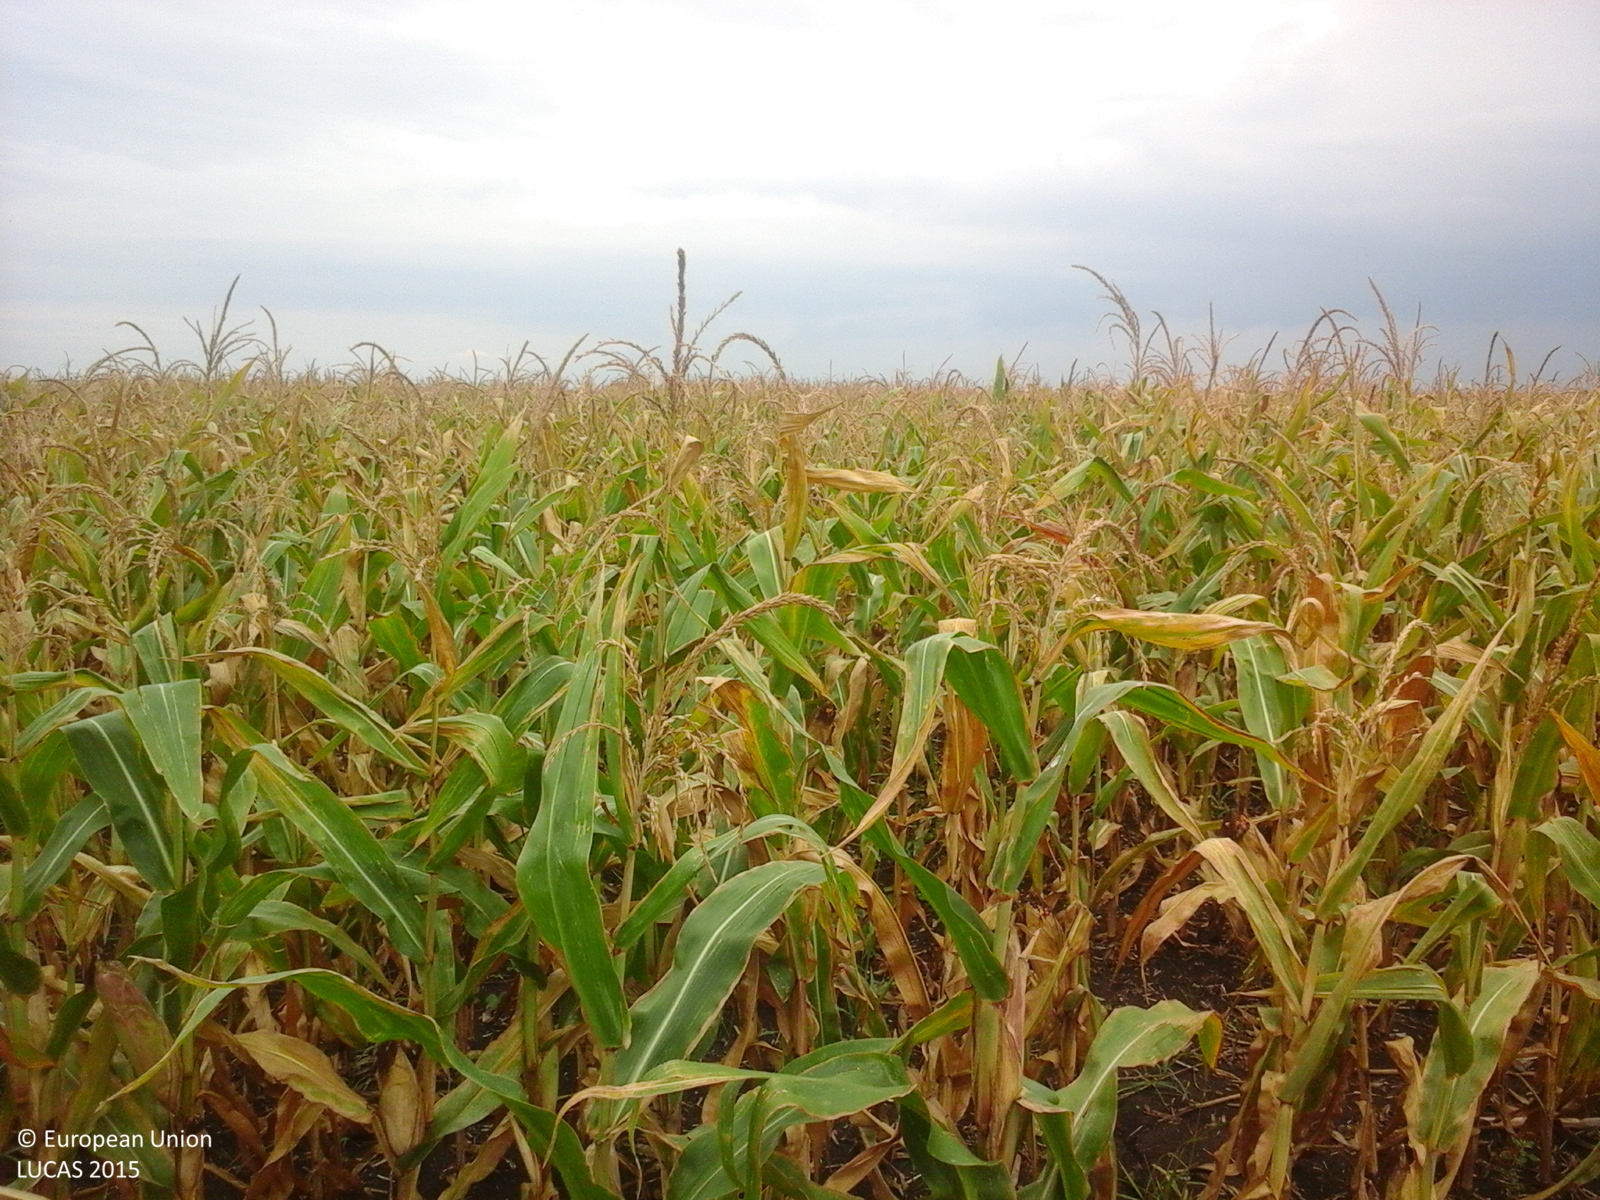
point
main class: Cropland
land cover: Maize
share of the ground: > 75 %
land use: Agriculture (excluding fallow land and kitchen gardens)
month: August
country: RO
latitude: 46.0274
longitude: 20.5536
